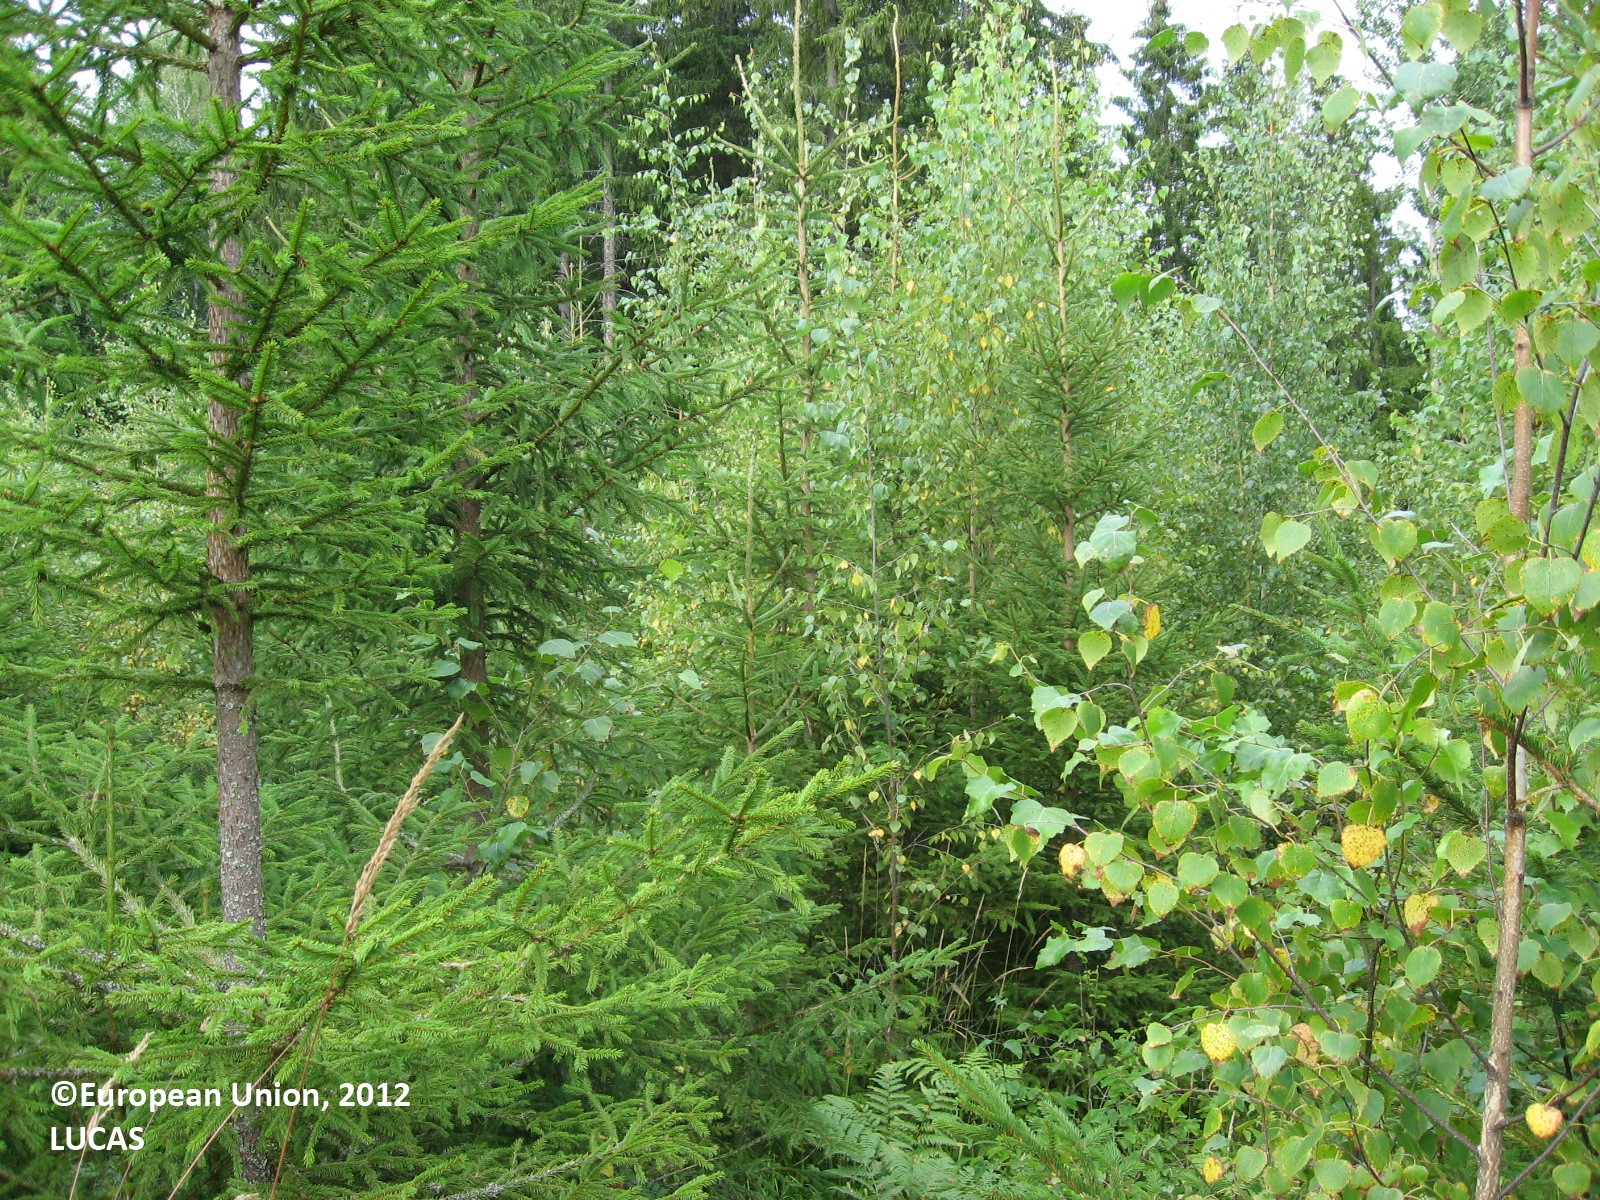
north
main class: Woodland
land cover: Spruce dominated mixed woodland
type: boreal forest
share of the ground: > 75 %
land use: Forestry
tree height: < 5 m
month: August
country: FI
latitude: 61.2271
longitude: 24.8396
